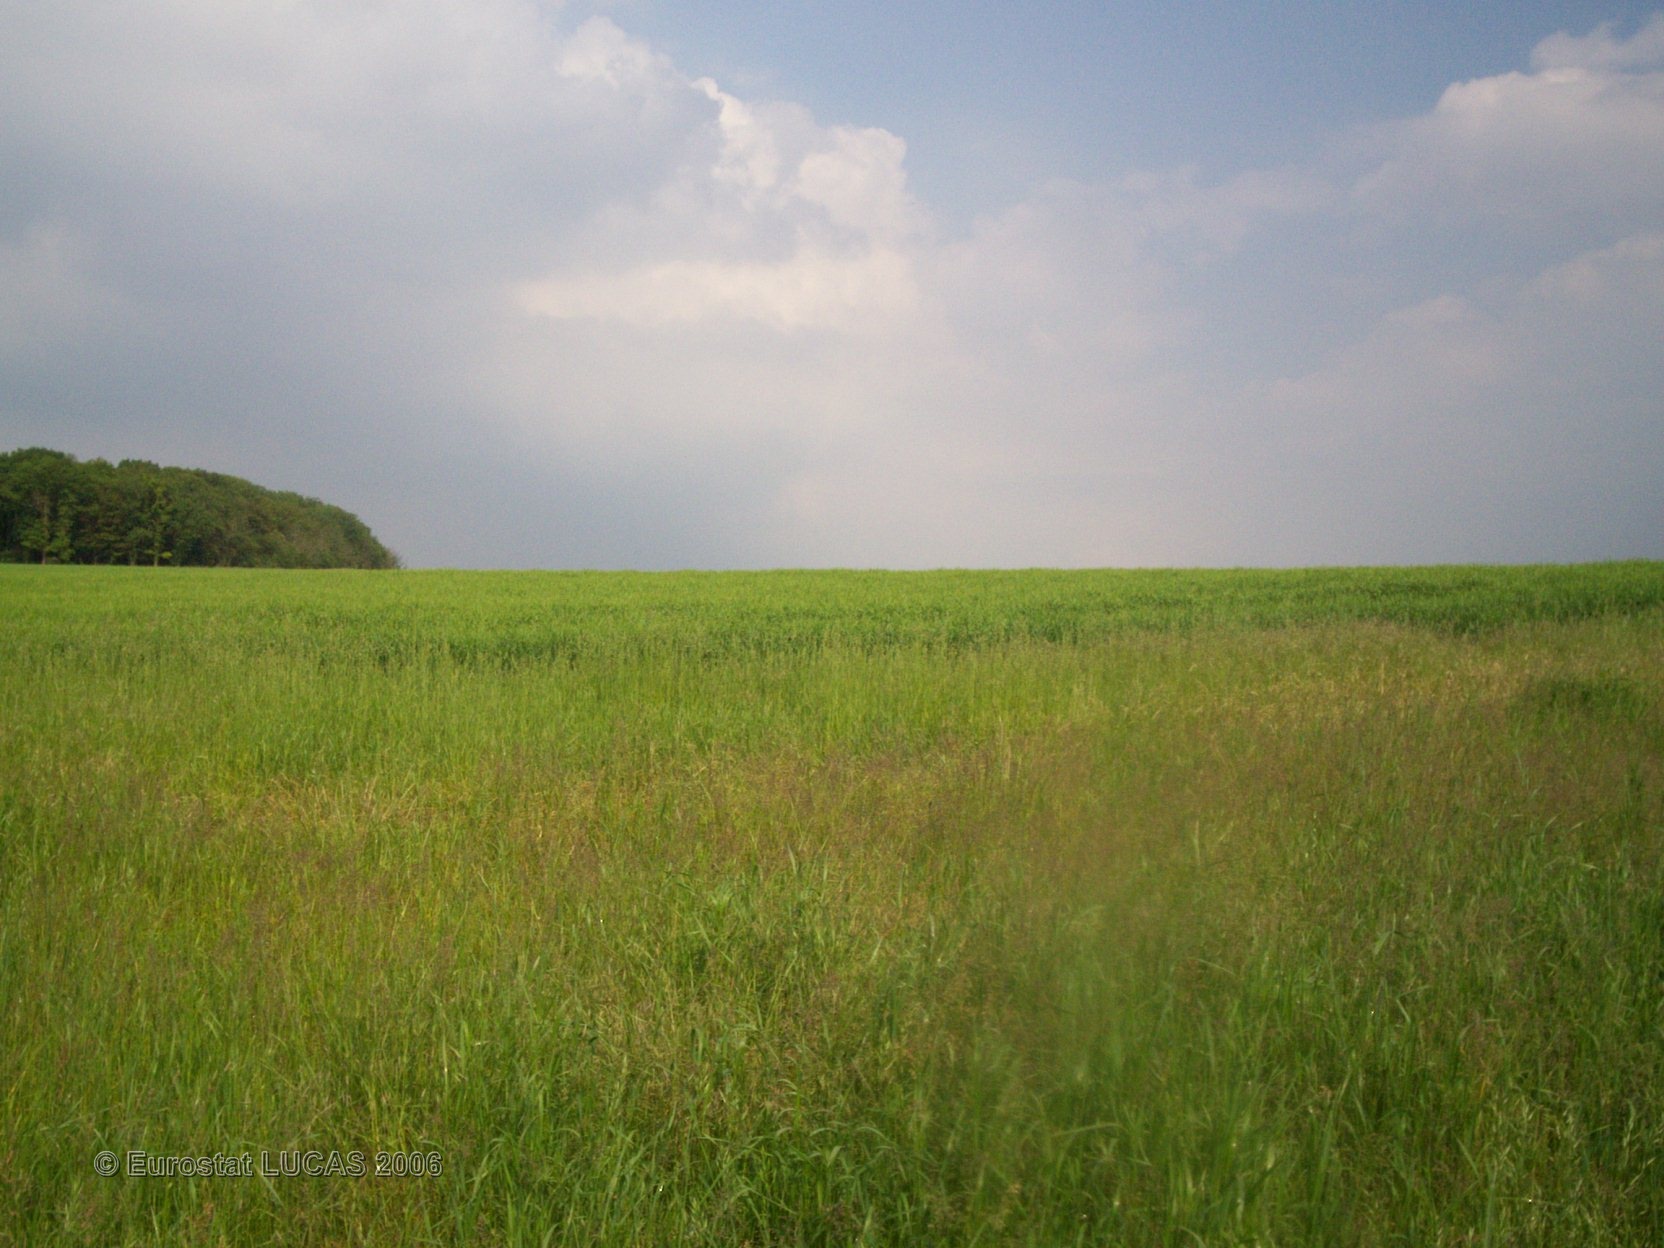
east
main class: Grassland
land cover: Grassland without tree/shrub cover
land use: Agriculture (excluding fallow land and kitchen gardens)
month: June
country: FR
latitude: 49.6962
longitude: 2.6827
